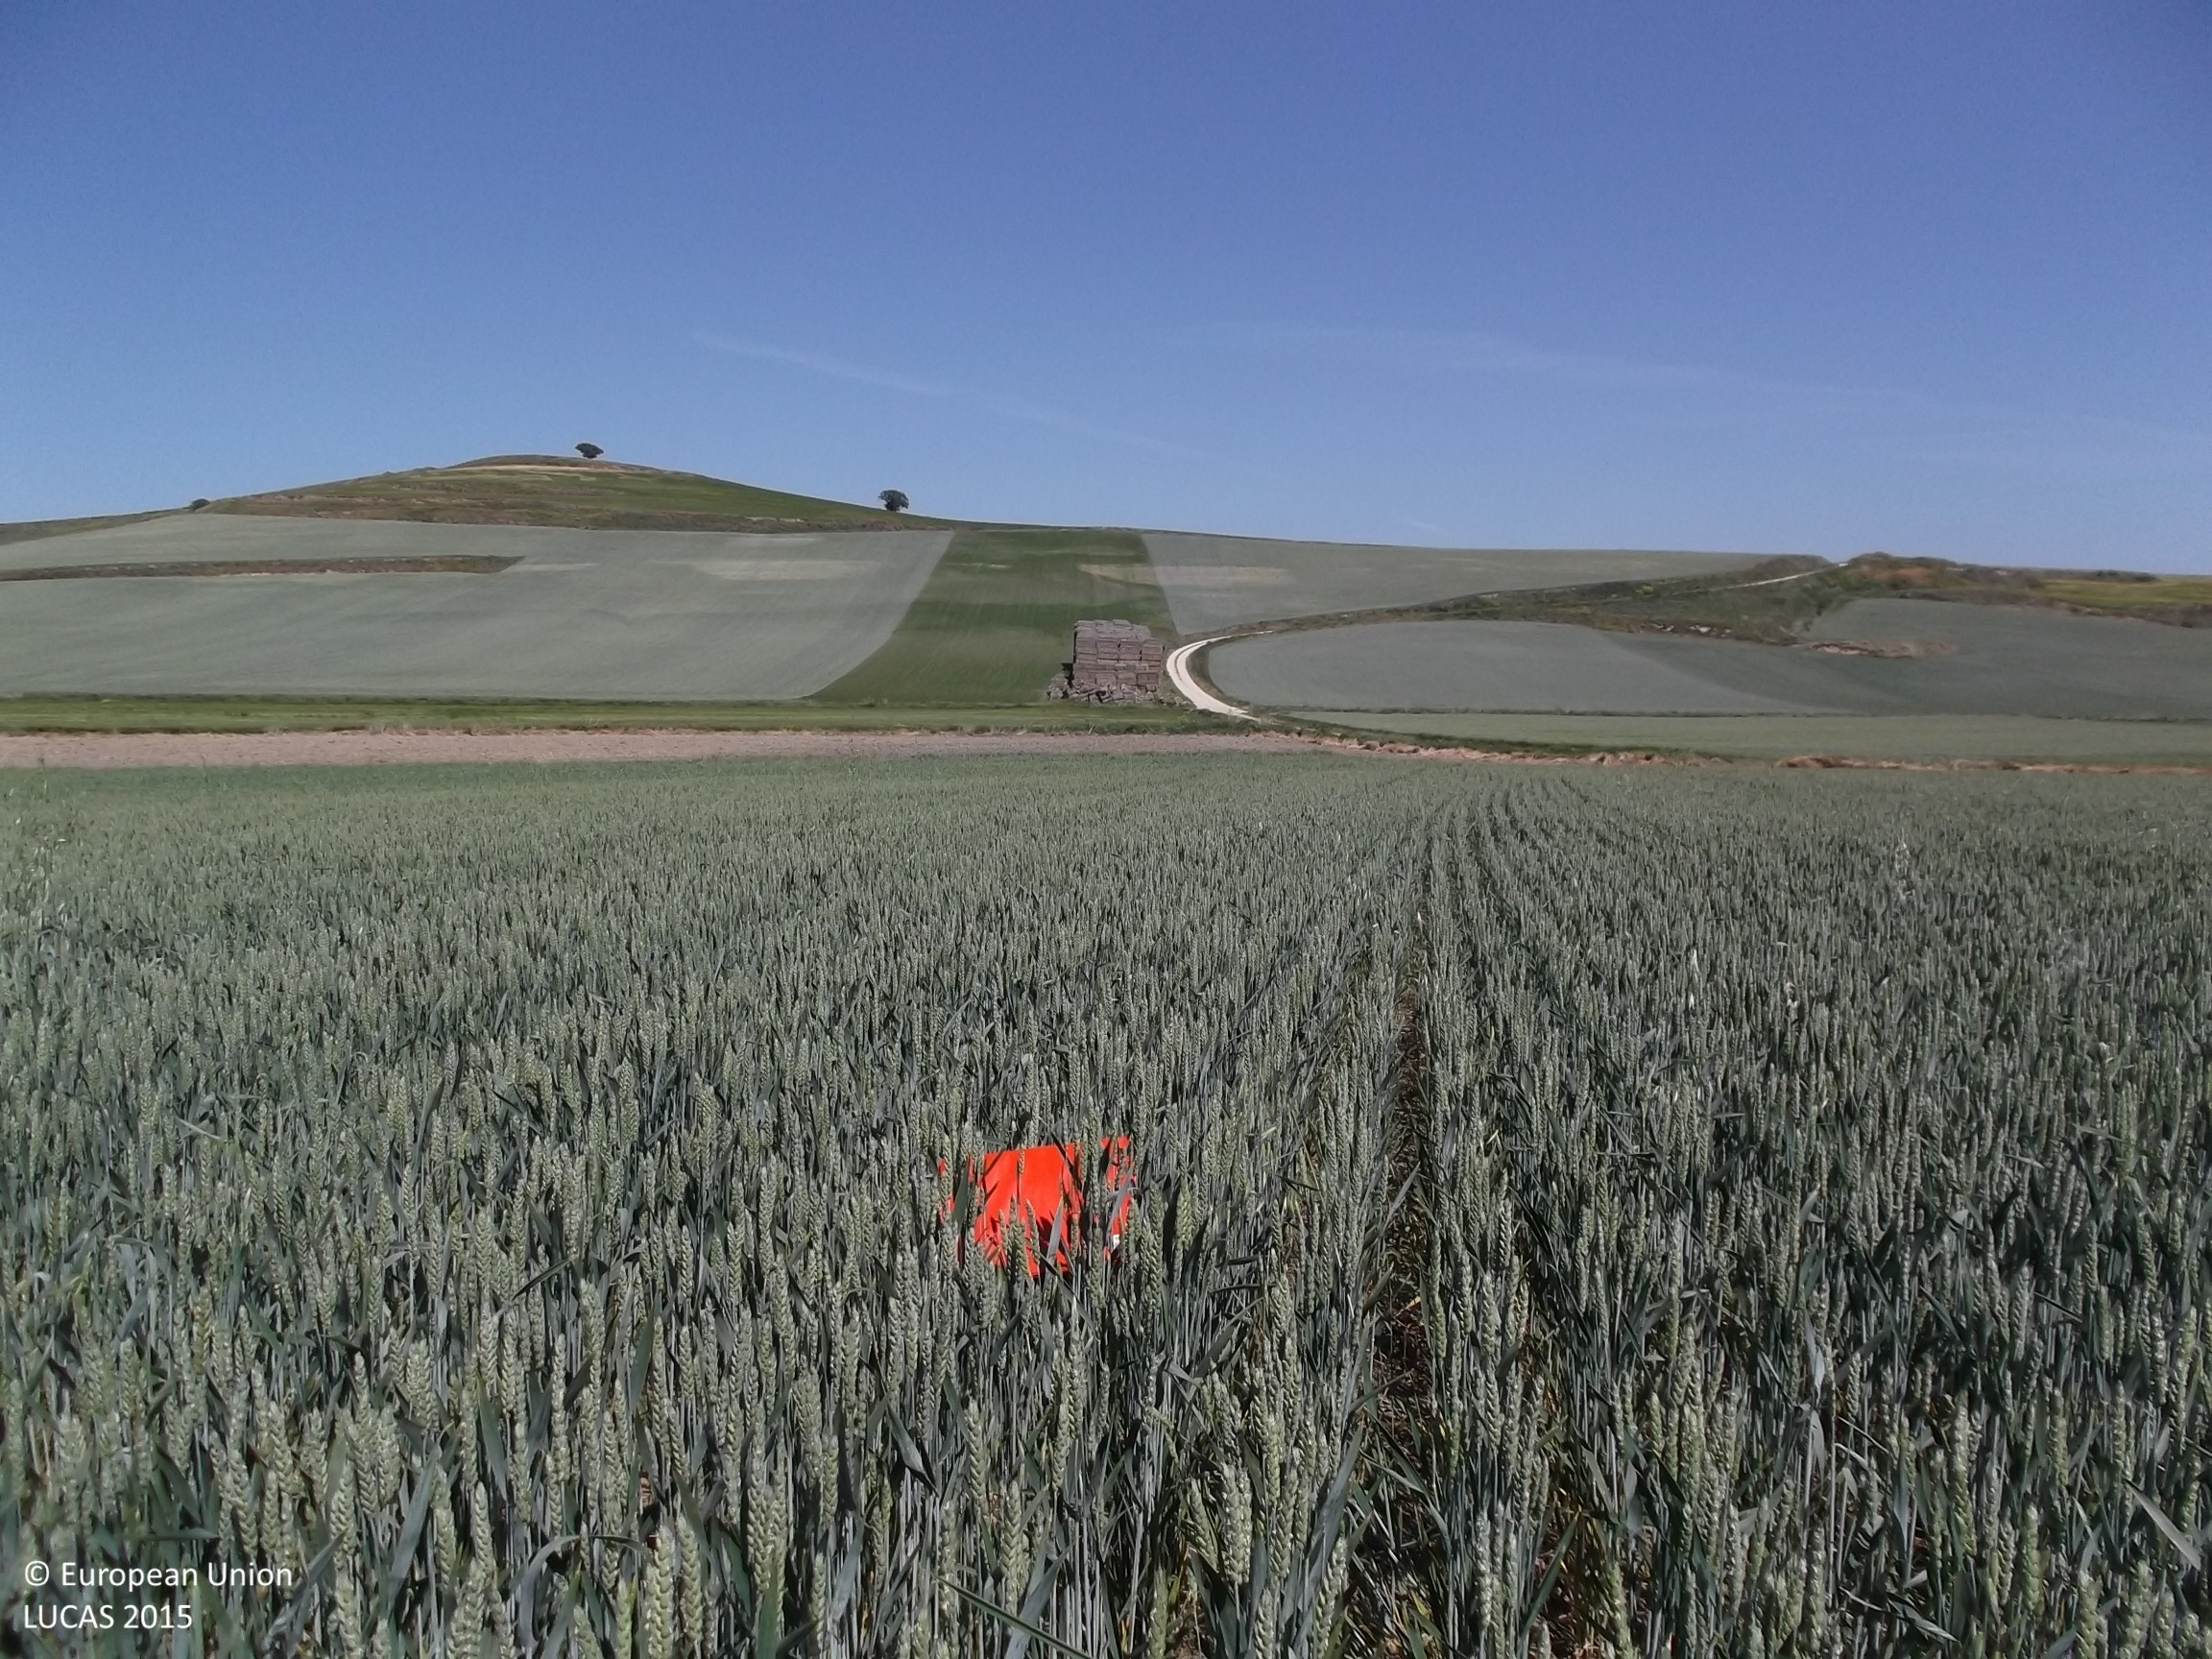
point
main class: Cropland
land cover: Common wheat
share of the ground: > 75 %
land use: Agriculture (excluding fallow land and kitchen gardens)
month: May
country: ES
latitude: 42.4808
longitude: -3.0569
